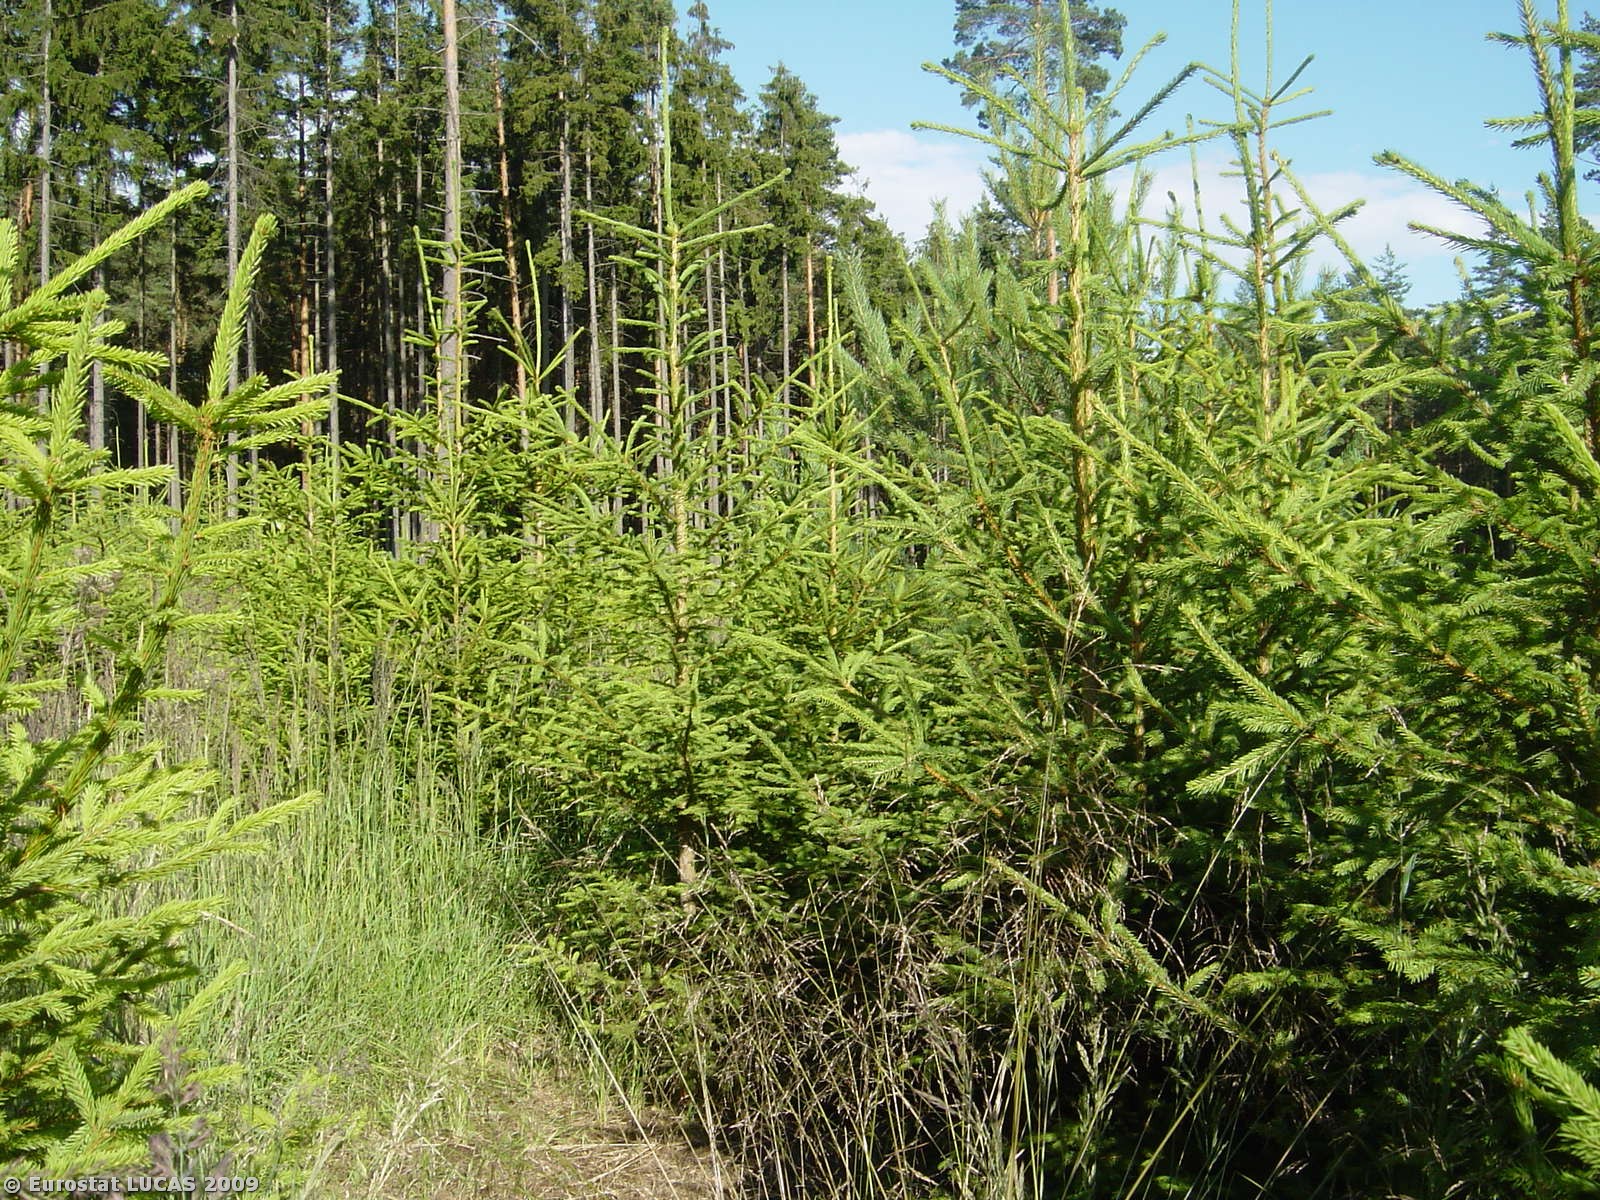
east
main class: Woodland
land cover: Coniferous woodland
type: hemiboreal forest and nemoral coniferous forest and mixed broadleaved-coniferous forest
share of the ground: > 75 %
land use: Forestry
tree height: > 5 m
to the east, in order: Coniferous woodland; Tracks; Coniferous woodland; Tracks; Coniferous woodland
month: July
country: CZ
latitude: 49.8413
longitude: 12.9060
